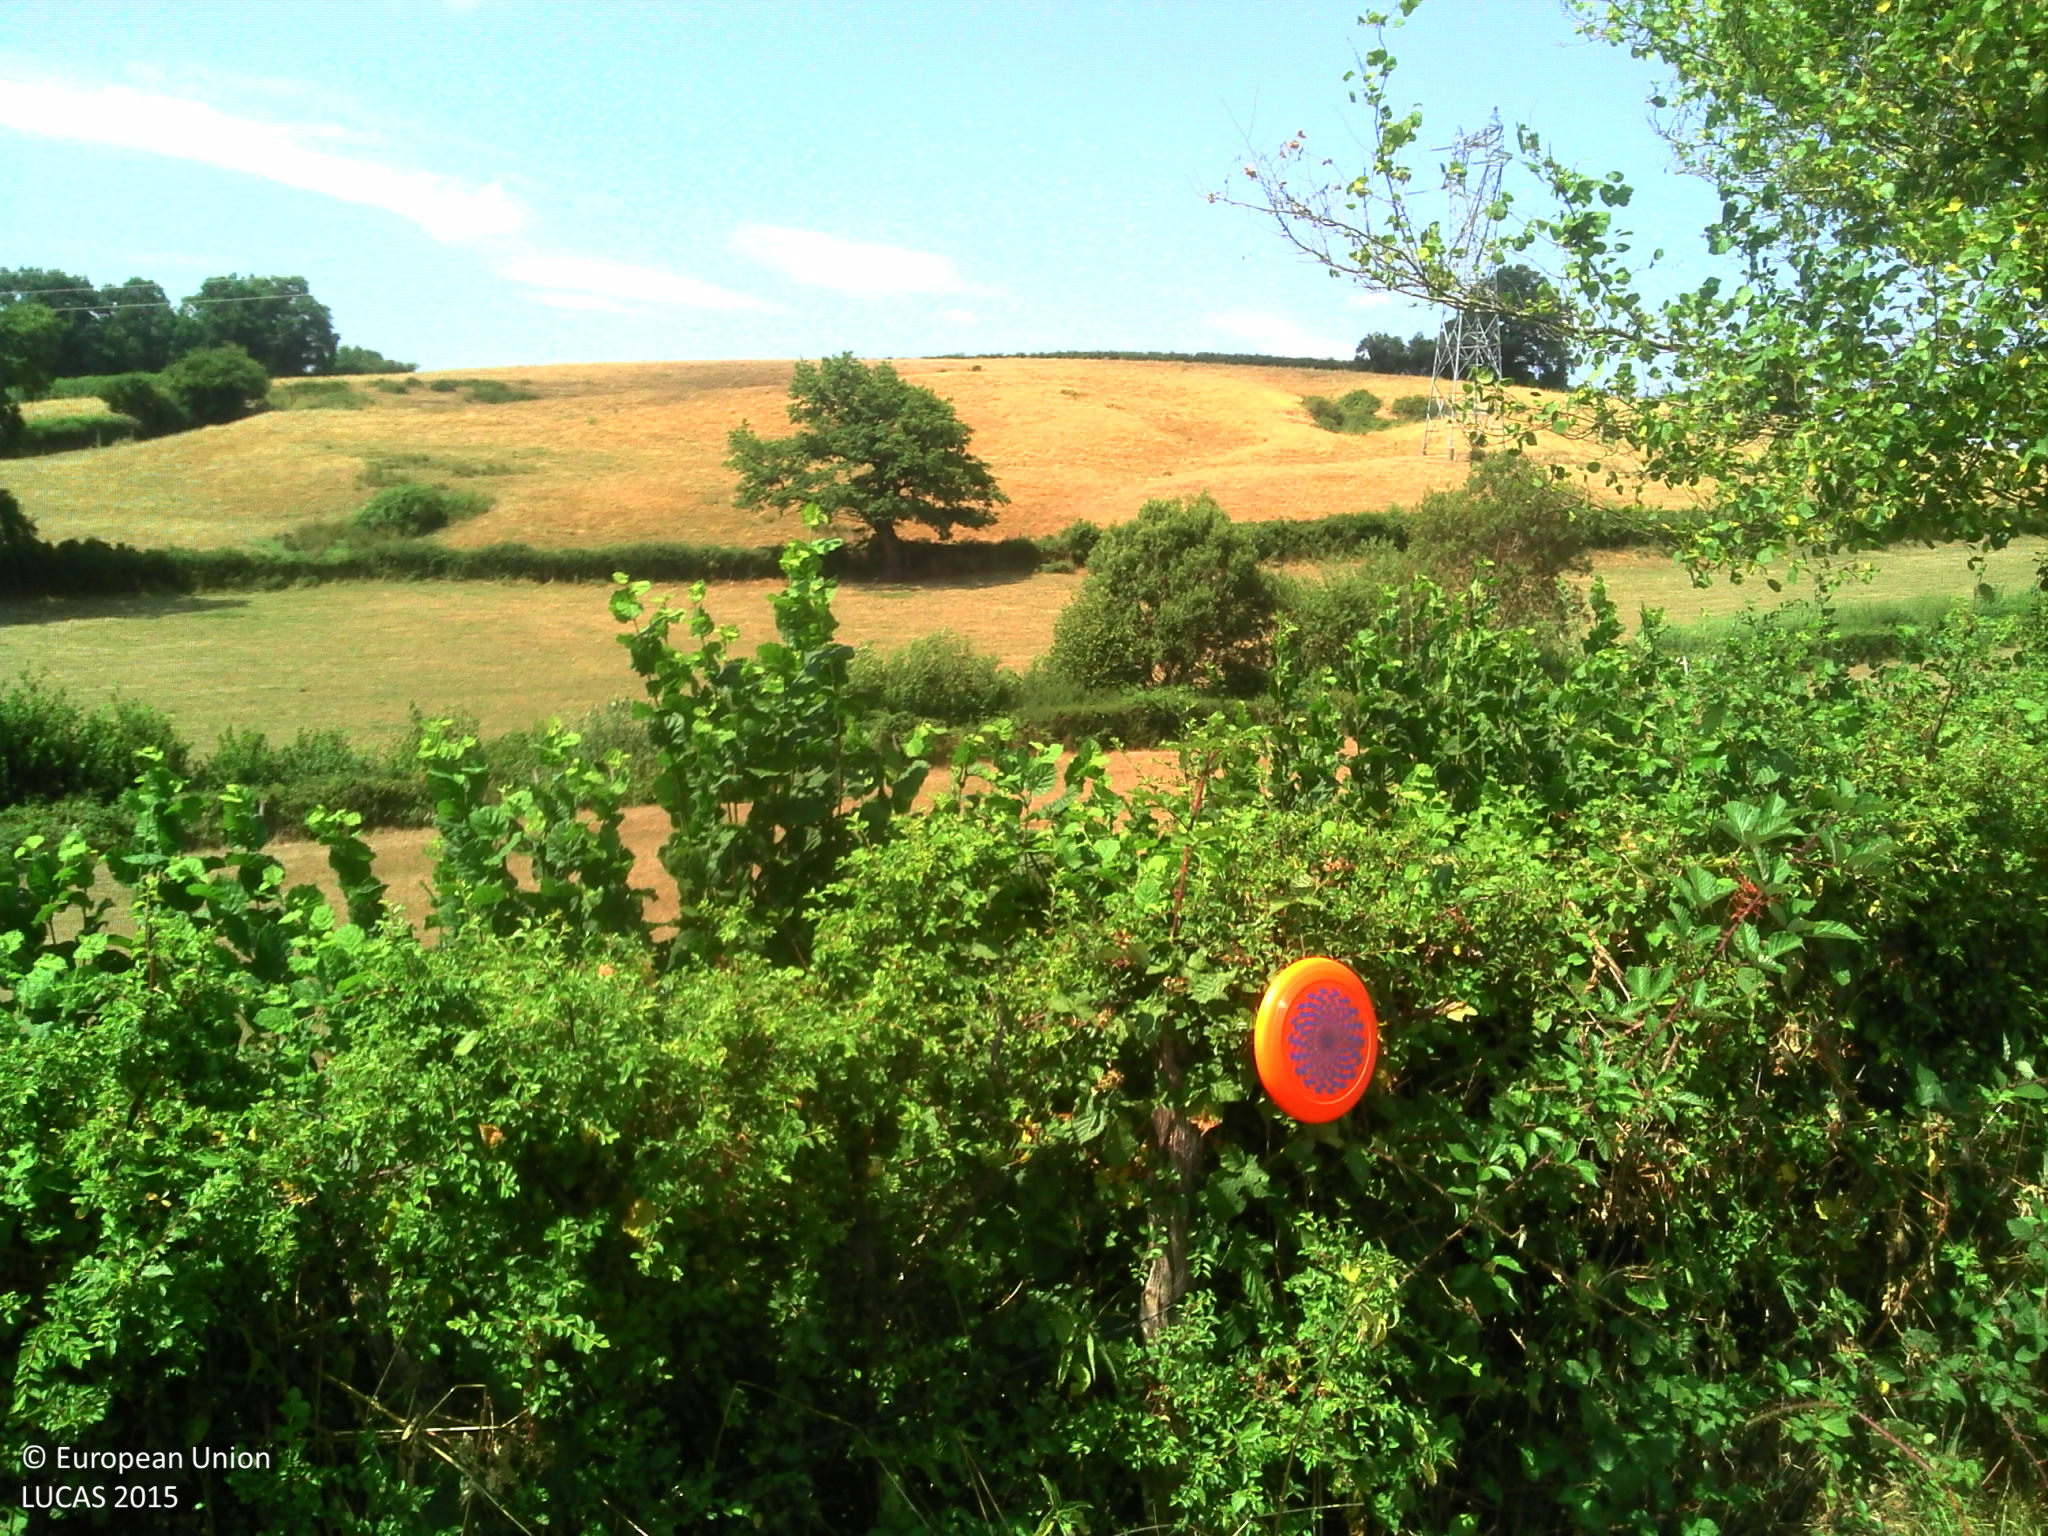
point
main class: Grassland
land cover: Grassland without tree/shrub cover
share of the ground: > 75 %
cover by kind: herbaceous plants 100 %
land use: Agriculture (excluding fallow land and kitchen gardens)
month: July
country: FR
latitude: 46.5644
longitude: 4.3783
